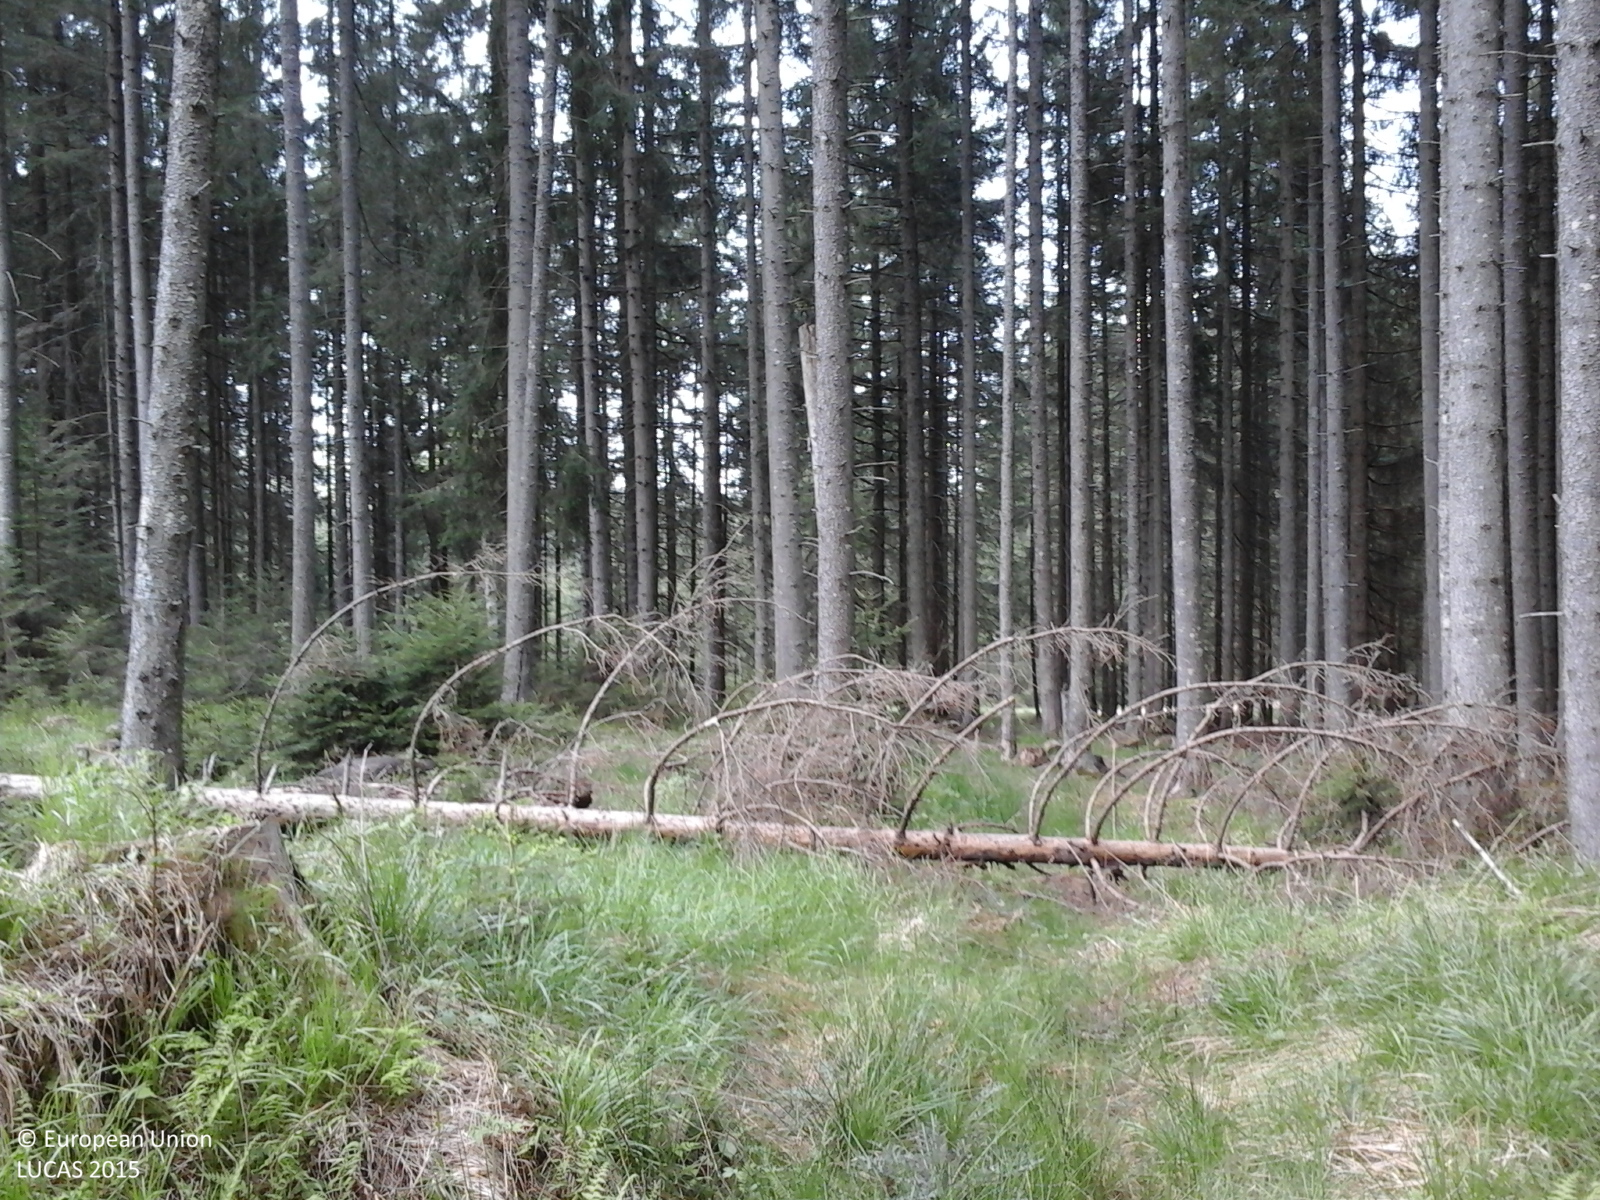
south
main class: Woodland
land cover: Spruce dominated coniferous woodland
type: alpine coniferous forest
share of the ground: > 75 %
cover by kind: coniferous forest trees 90 %, herbaceous plants 10 %
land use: Forestry
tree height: > 5 m
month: May
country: RO
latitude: 45.6703
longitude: 26.2297
